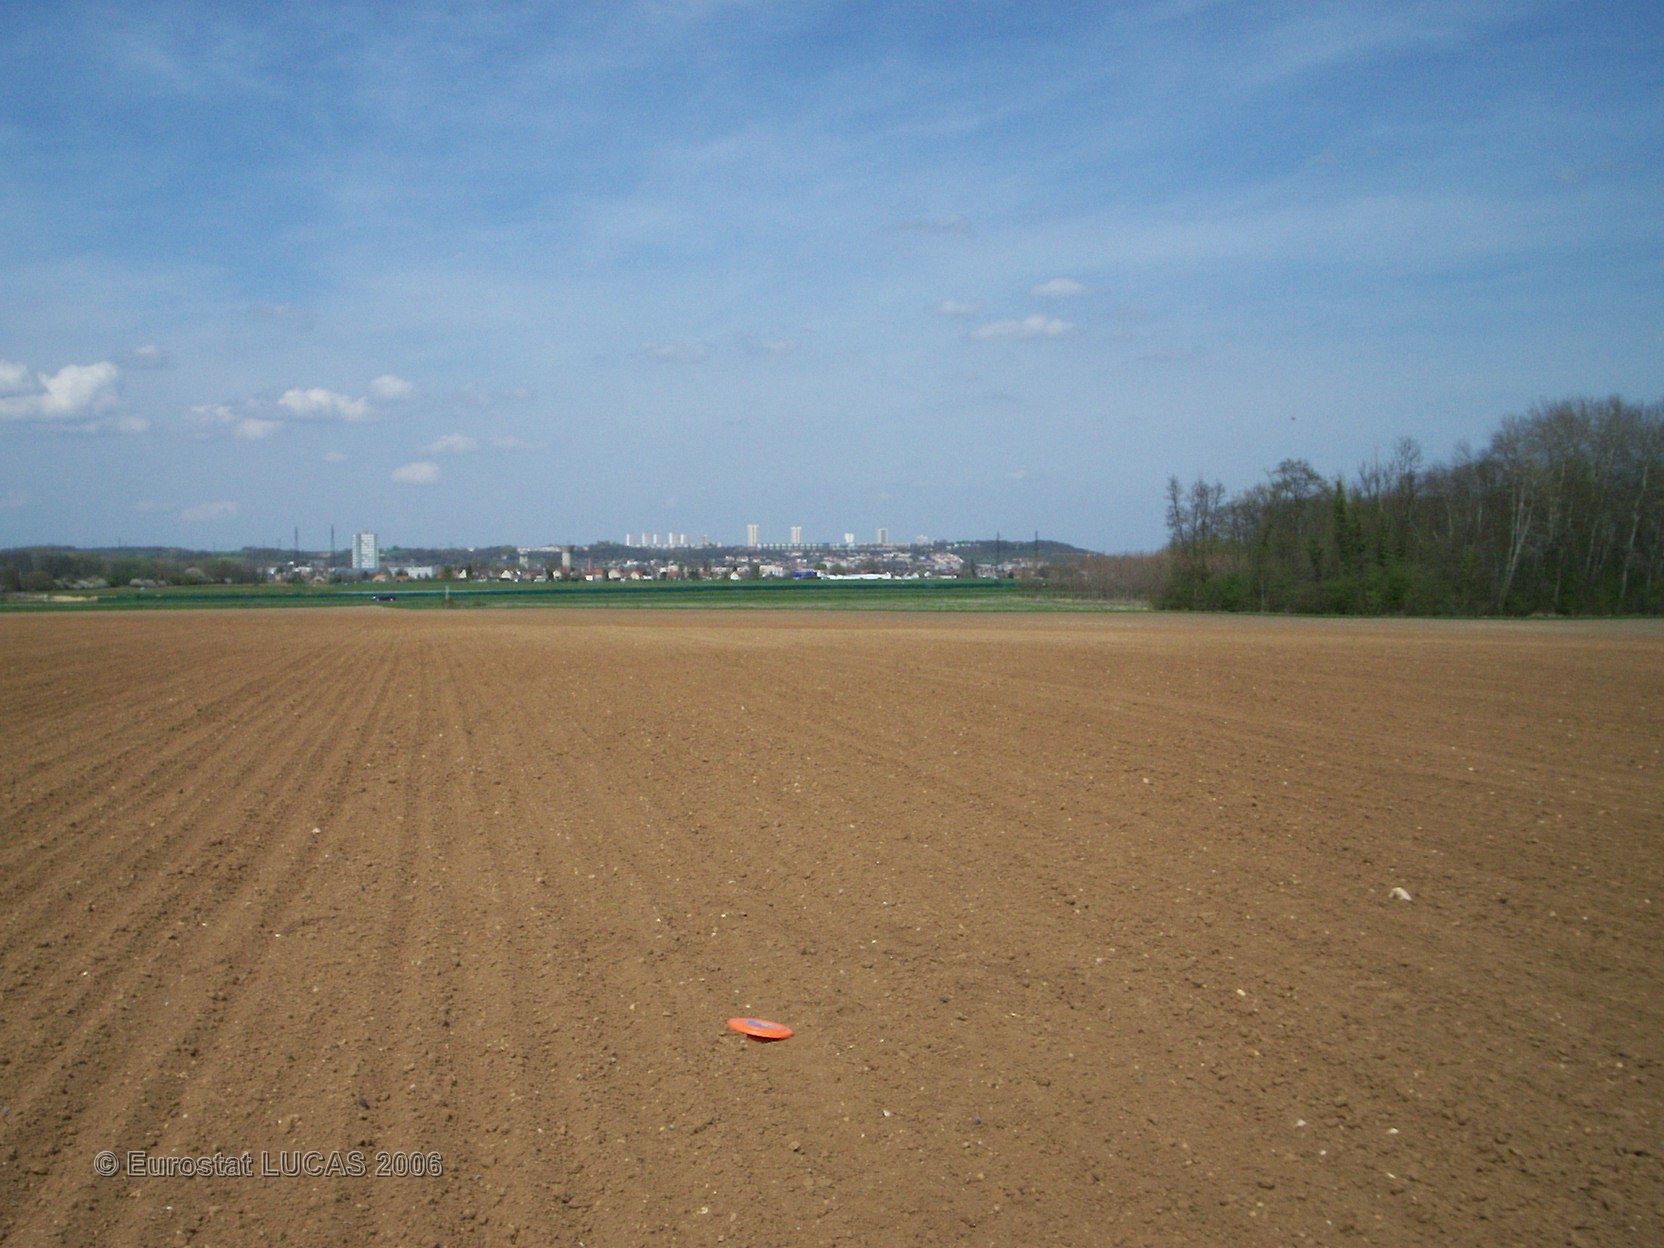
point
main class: Cropland
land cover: Sugar beet
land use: Agriculture (excluding fallow land and kitchen gardens)
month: April
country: FR
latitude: 48.3579
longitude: 2.9334
